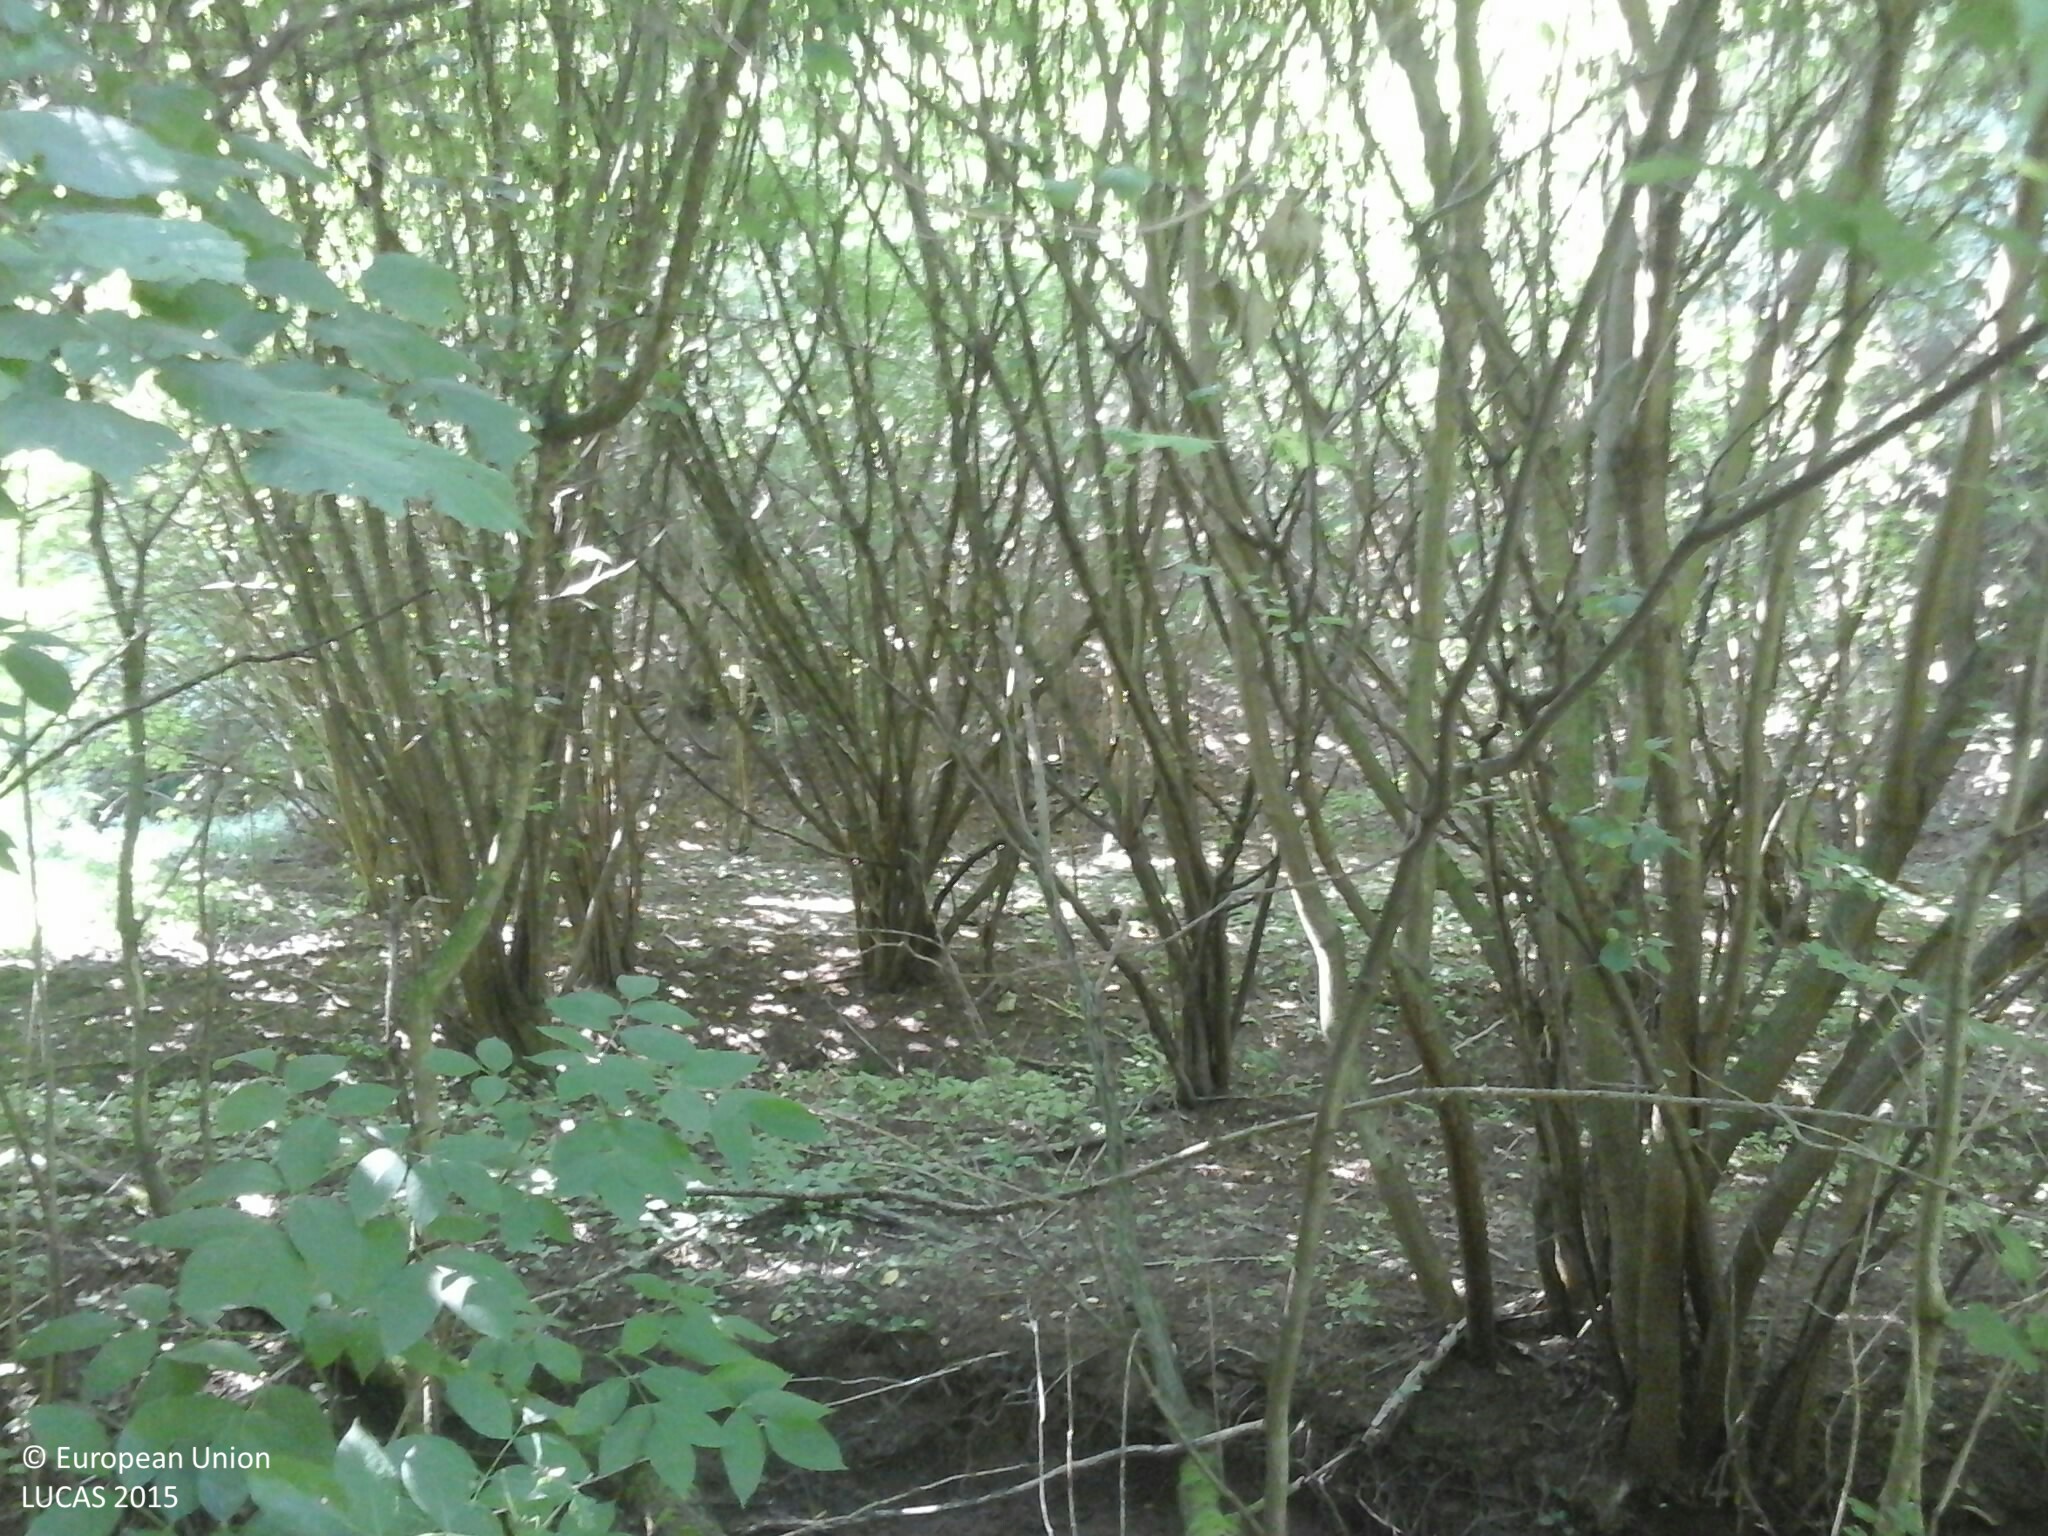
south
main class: Woodland
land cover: Broadleaved woodland
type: mesophytic deciduous forest
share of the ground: > 75 %
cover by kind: broadleaved forest trees 100 %
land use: Forestry
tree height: > 5 m
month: August
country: HU
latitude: 46.1165
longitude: 18.0938
